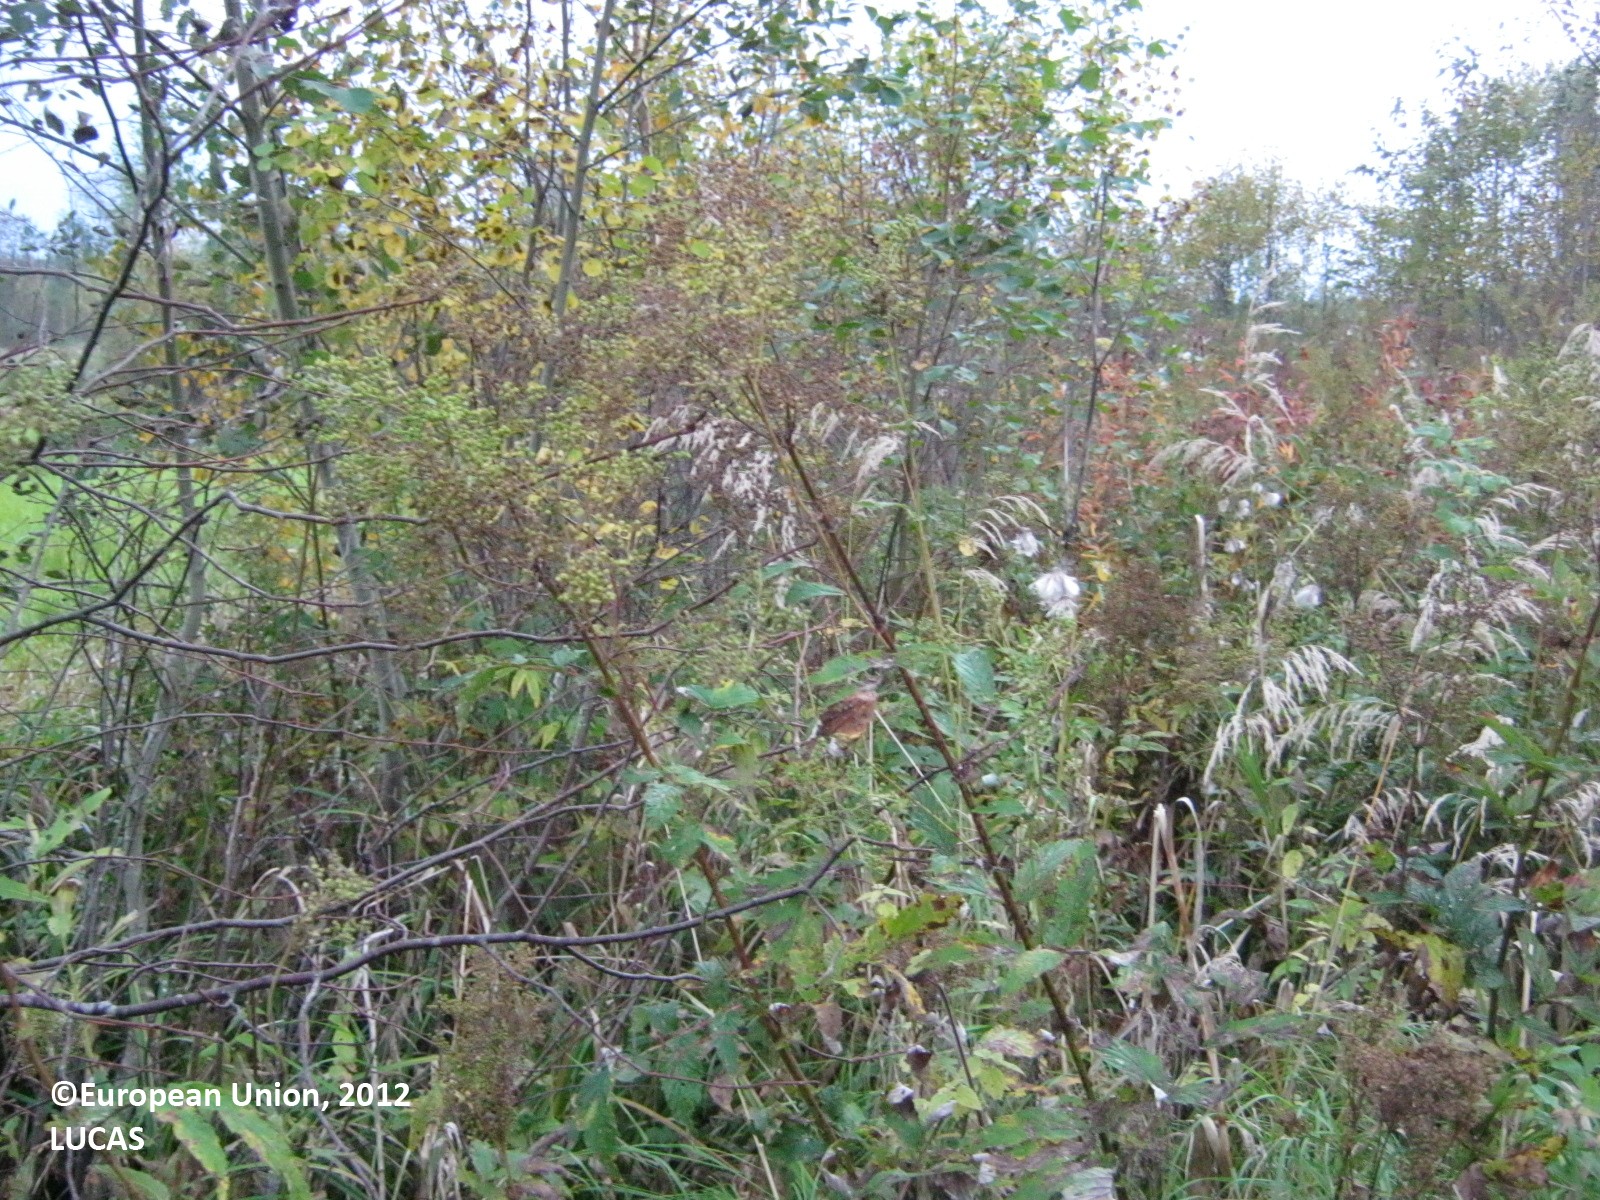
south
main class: Woodland
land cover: Broadleaved woodland
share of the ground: > 75 %
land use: Forestry
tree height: < 5 m
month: September
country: FI
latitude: 61.0083
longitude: 28.1639
